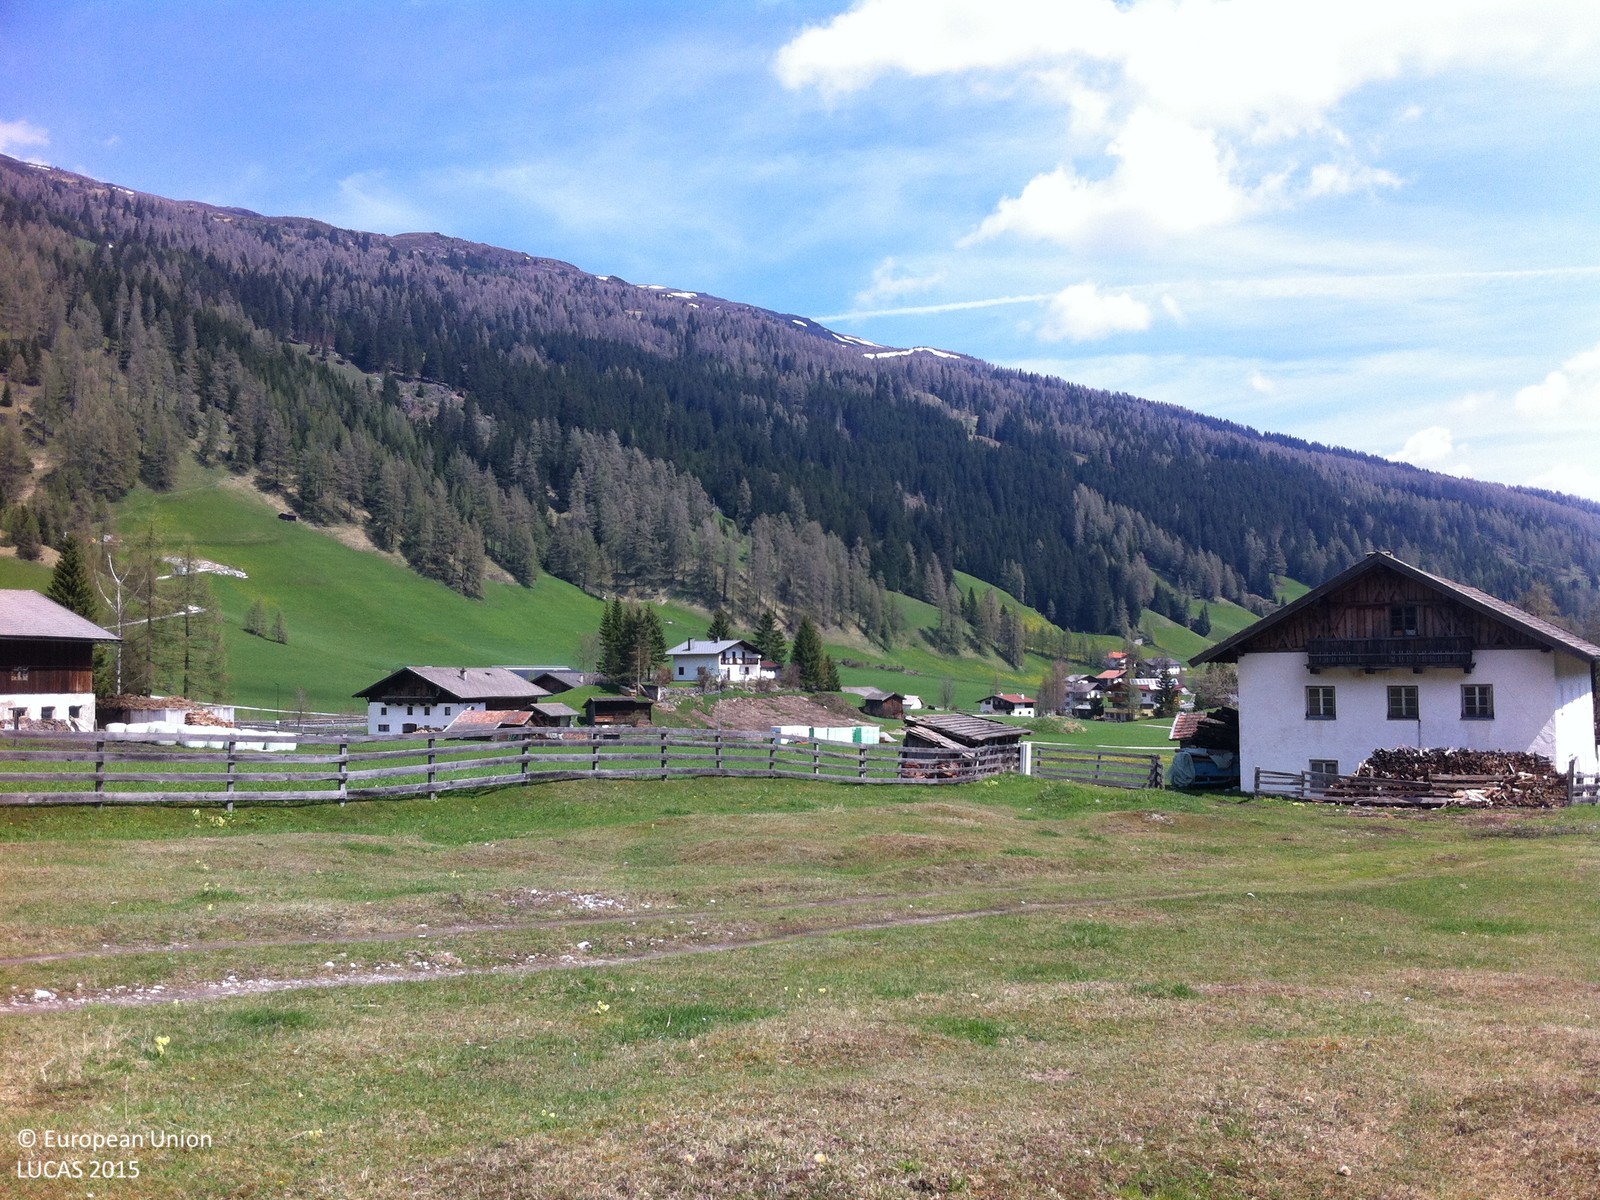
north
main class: Grassland
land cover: Grassland without tree/shrub cover
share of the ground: > 75 %
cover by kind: herbaceous plants 100 %
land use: Agriculture (excluding fallow land and kitchen gardens)
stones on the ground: < 10 %
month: May
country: AT
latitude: 47.0084
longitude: 11.4060
